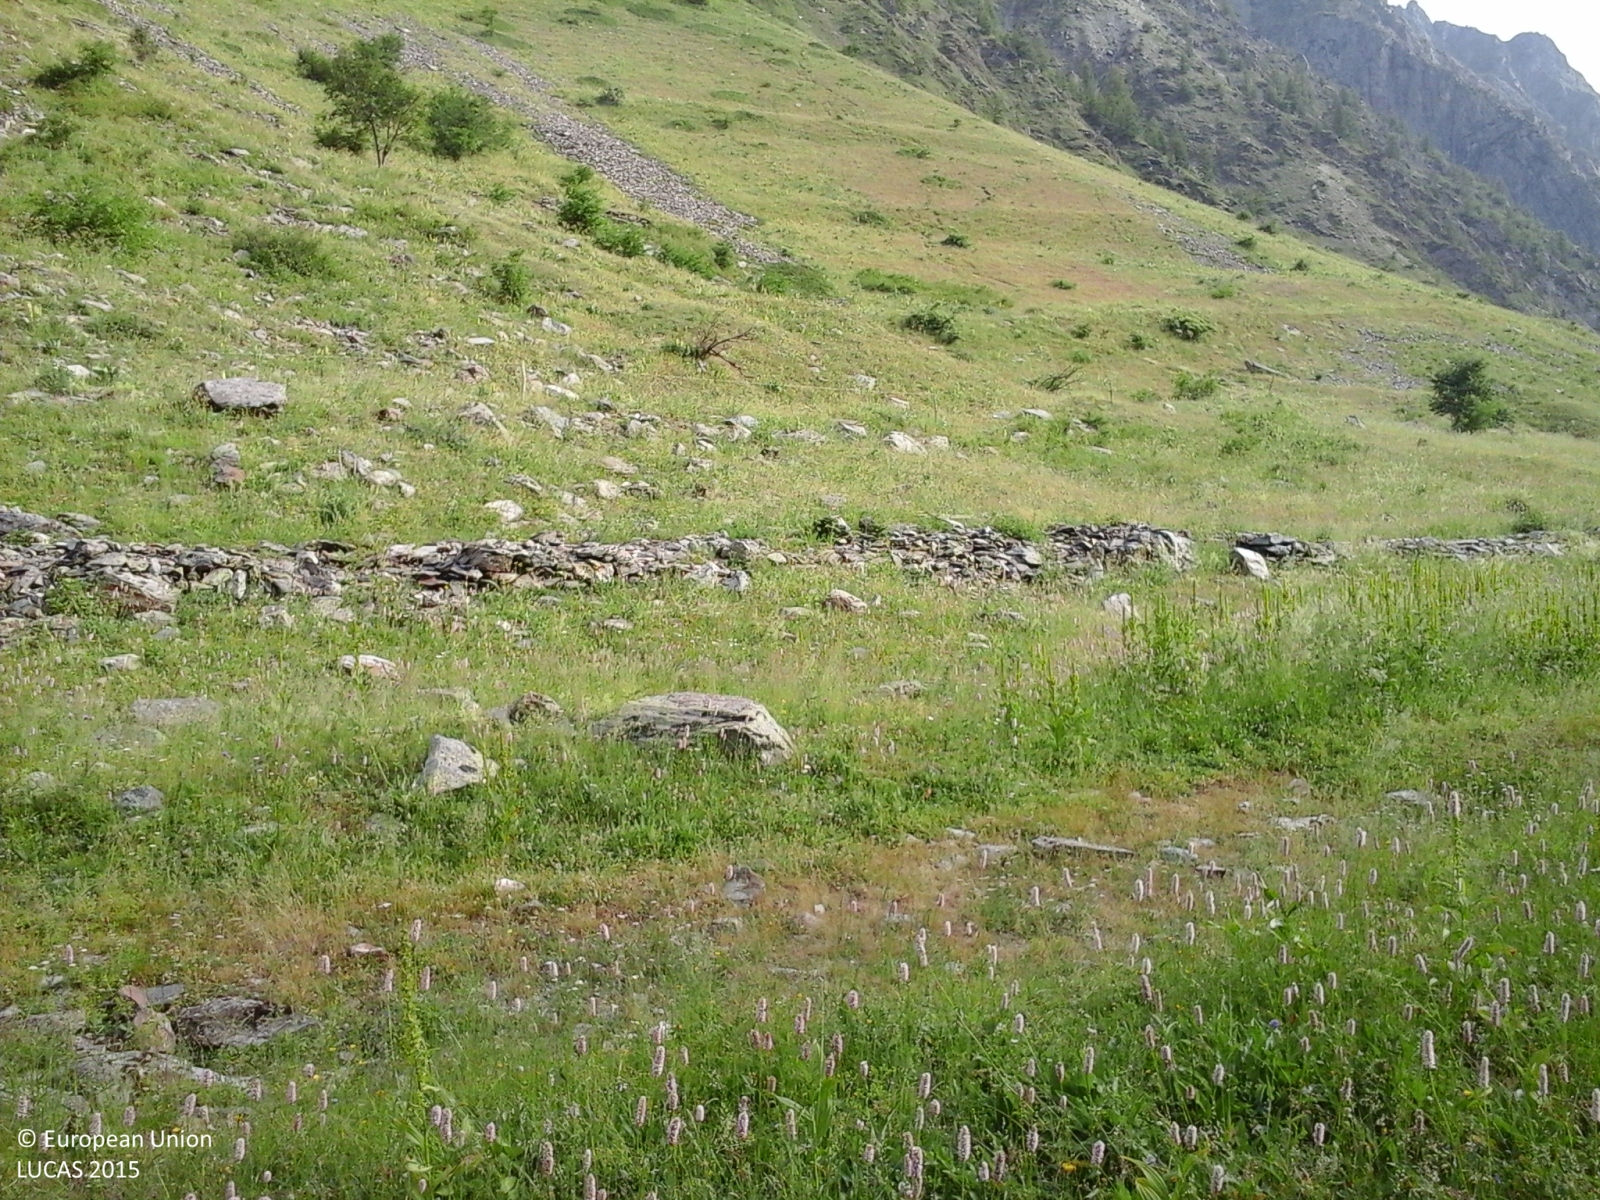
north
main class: Grassland
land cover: Grassland without tree/shrub cover
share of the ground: > 75 %
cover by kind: herbaceous plants 90 %, consolidated bare surface 10 %
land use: Agriculture (excluding fallow land and kitchen gardens)
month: July
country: IT
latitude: 44.3248
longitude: 6.9841
